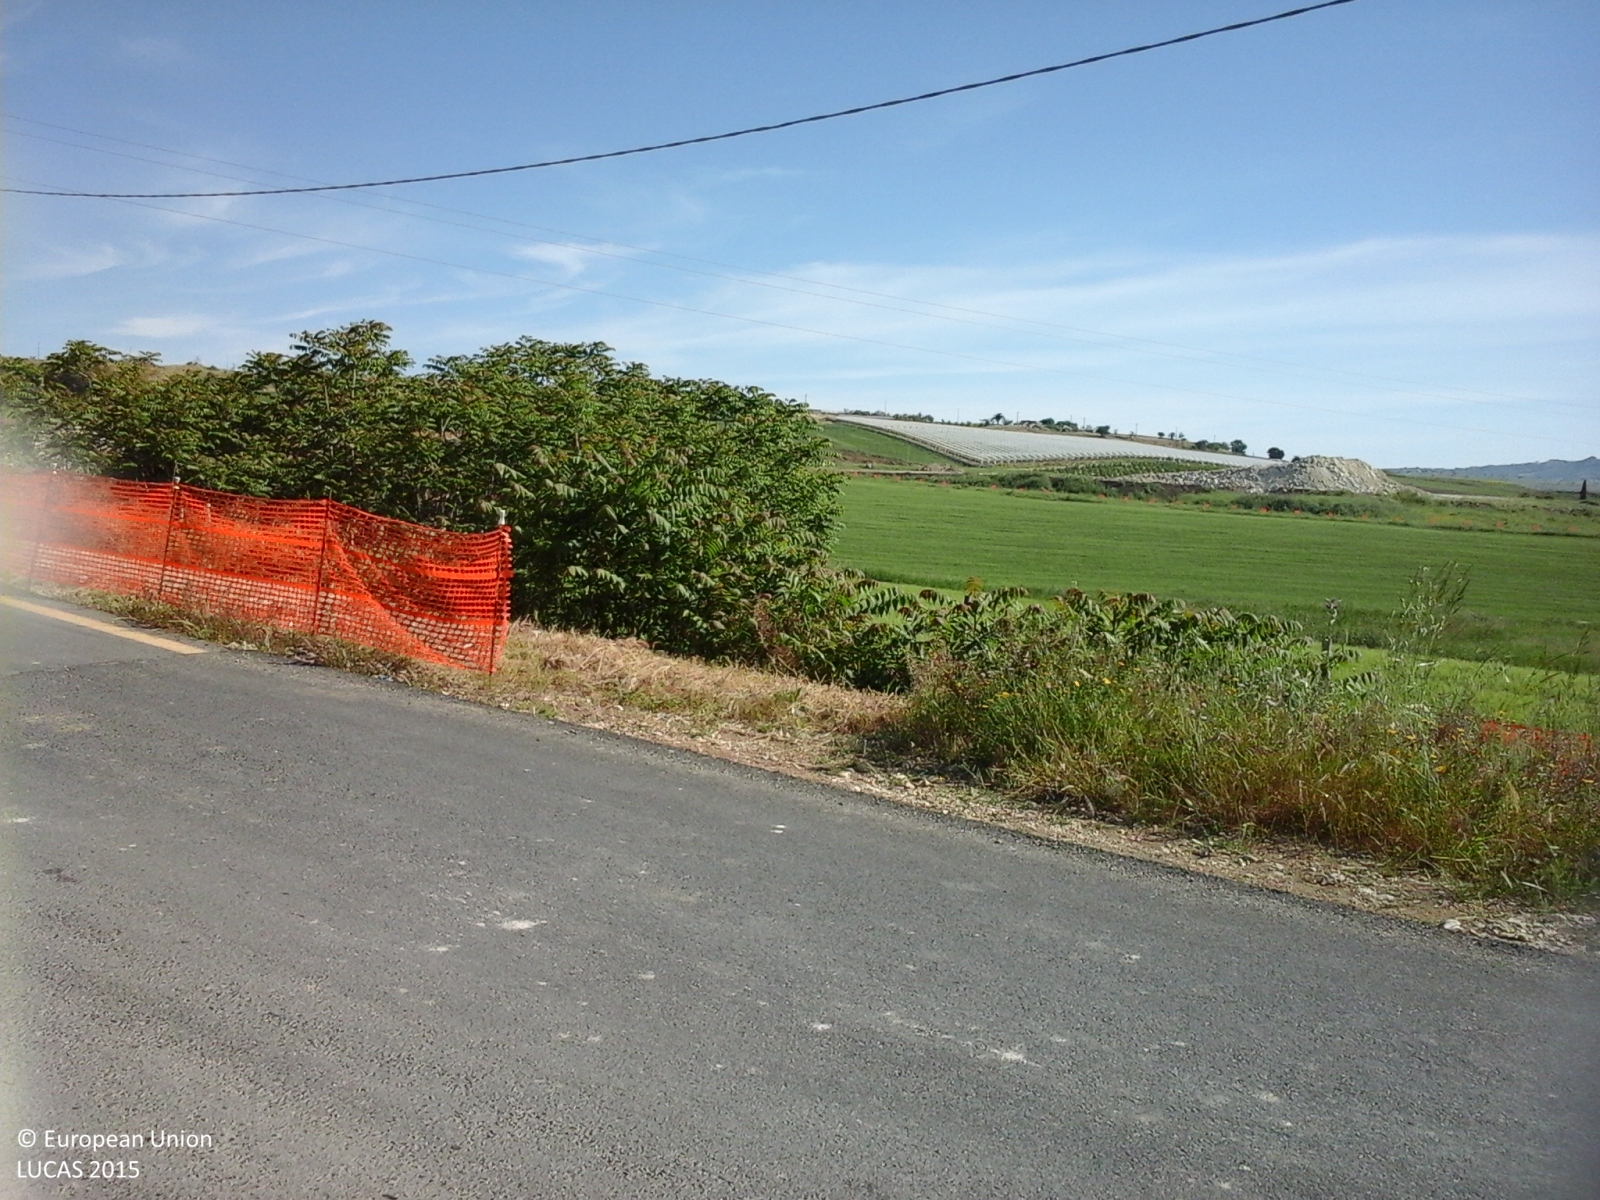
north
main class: Cropland
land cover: Vineyards
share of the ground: > 75 %
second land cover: Other bare soil
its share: > 75 %
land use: Agriculture (excluding fallow land and kitchen gardens)
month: May
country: IT
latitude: 37.4126
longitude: 13.9133
